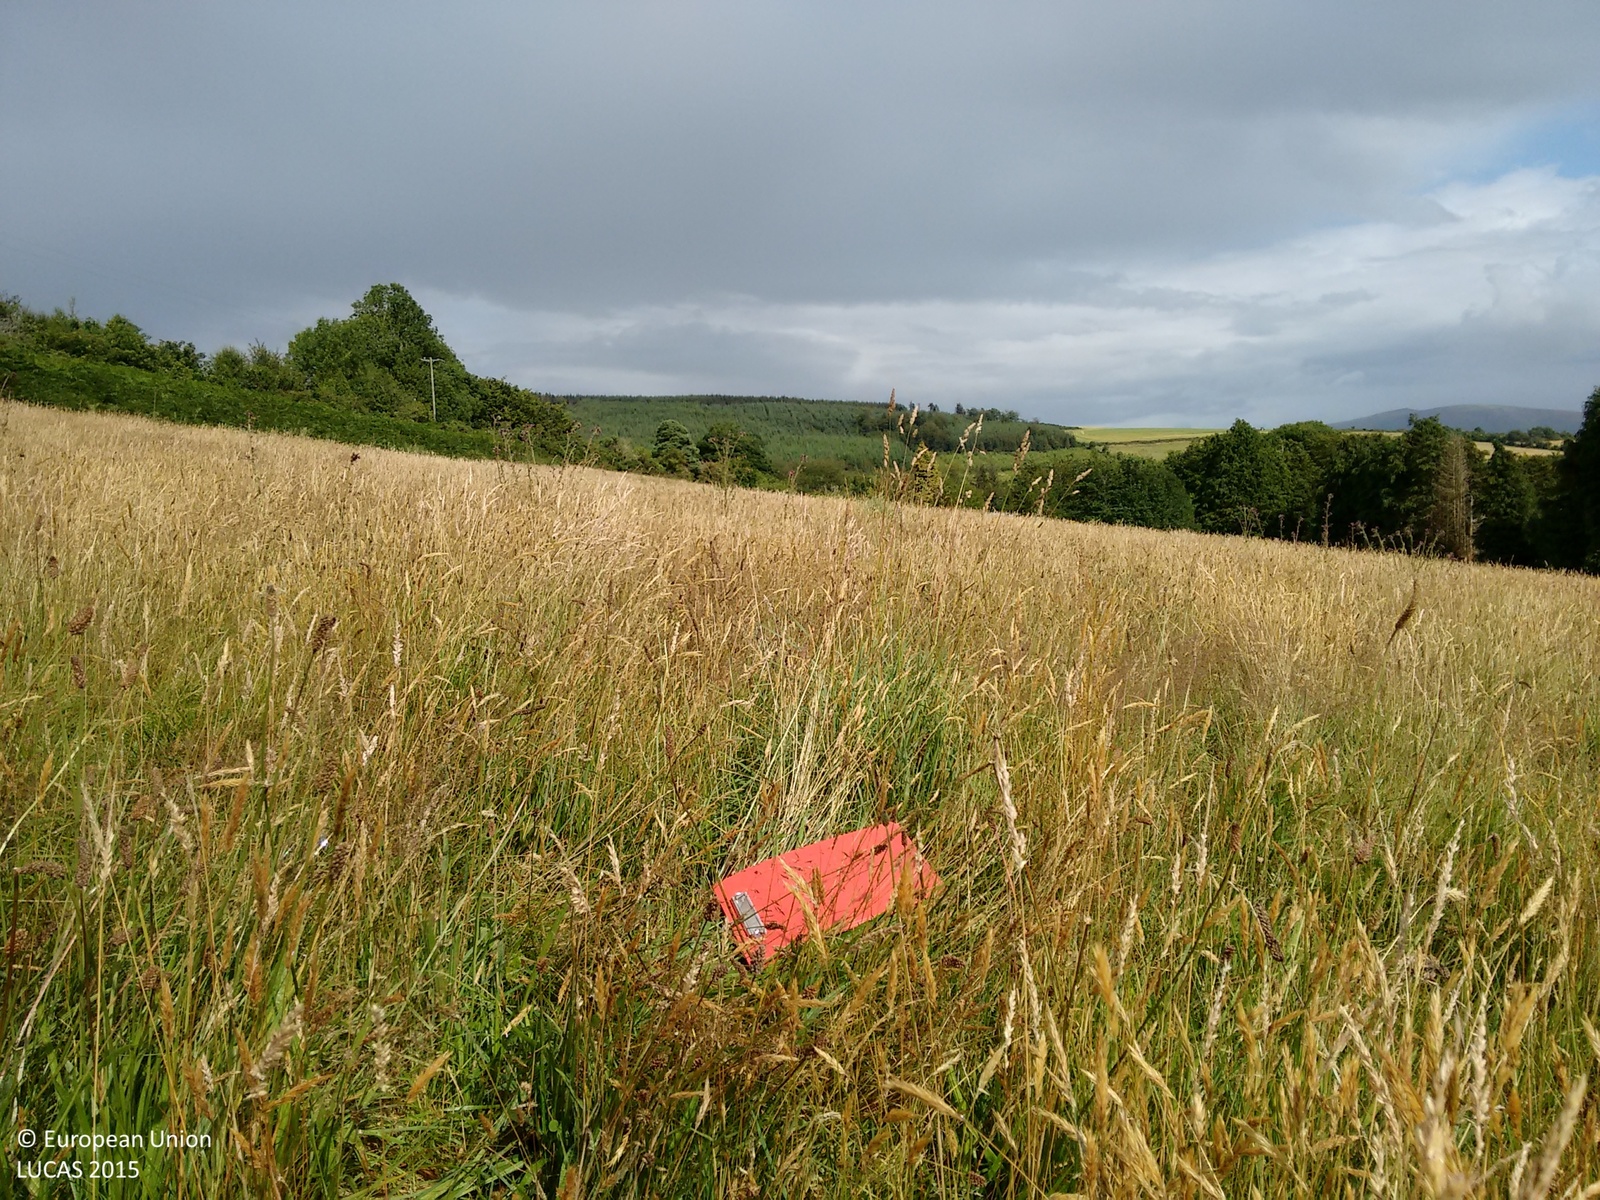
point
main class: Grassland
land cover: Grassland without tree/shrub cover
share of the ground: > 75 %
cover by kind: herbaceous plants 100 %
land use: Agriculture (excluding fallow land and kitchen gardens)
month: July
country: IE
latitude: 52.8365
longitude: -6.4399
